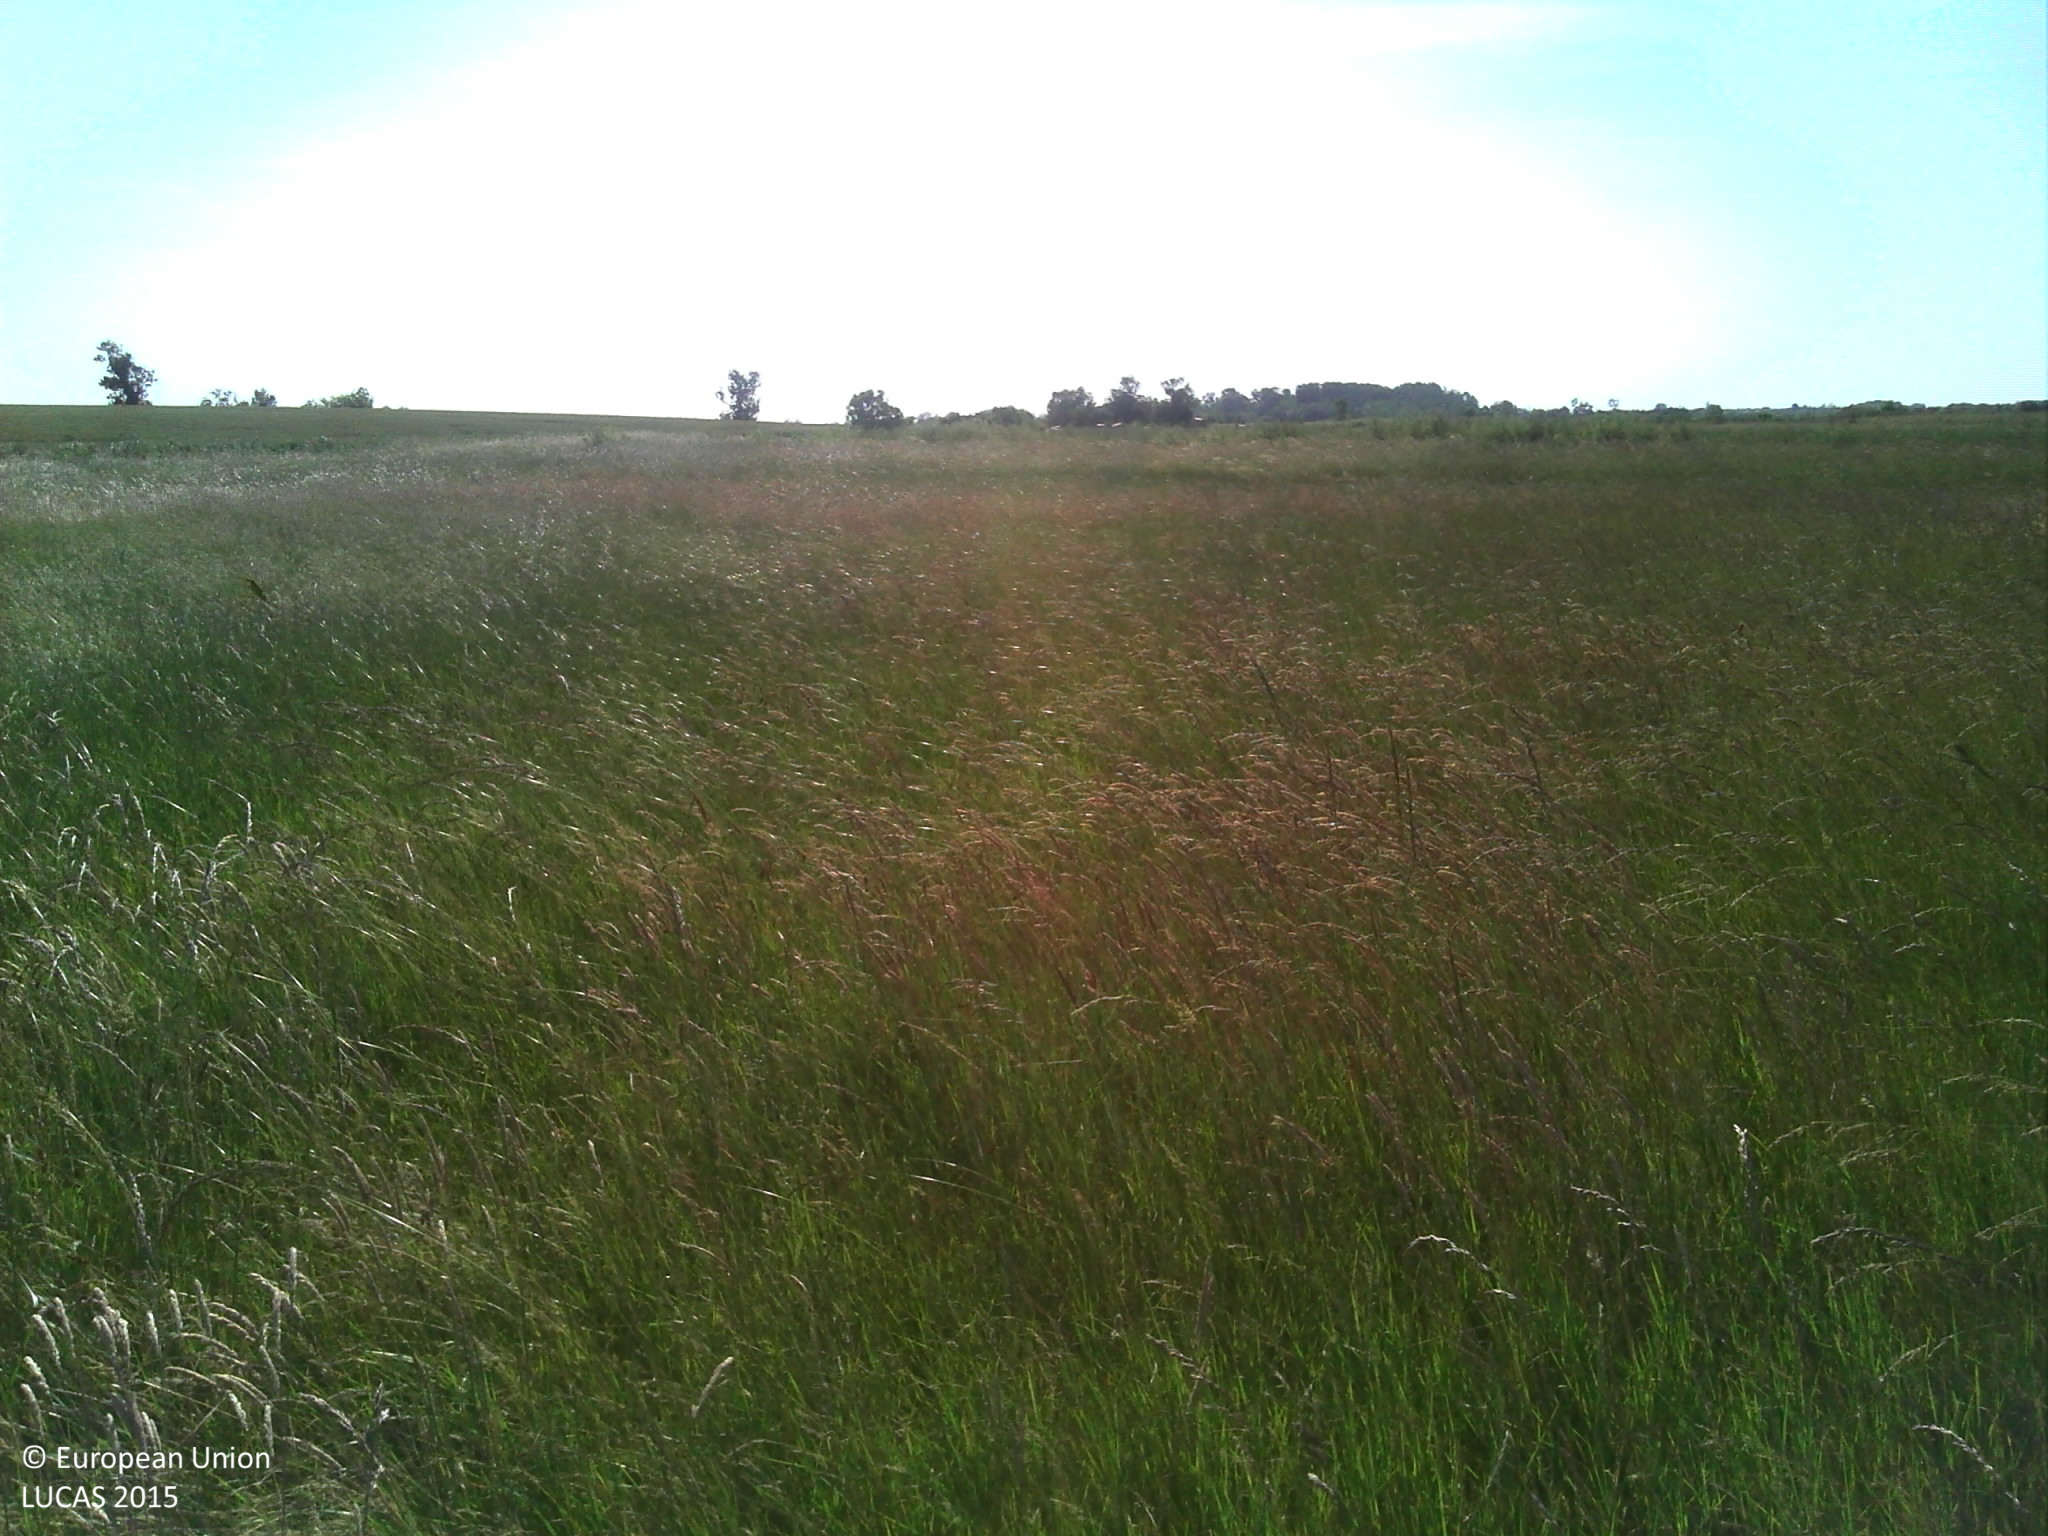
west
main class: Grassland
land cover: Grassland without tree/shrub cover
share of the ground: > 75 %
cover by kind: herbaceous plants 95 %, shrubs 5 %
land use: Agriculture (excluding fallow land and kitchen gardens)
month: June
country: FR
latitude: 46.0517
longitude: -1.0286
